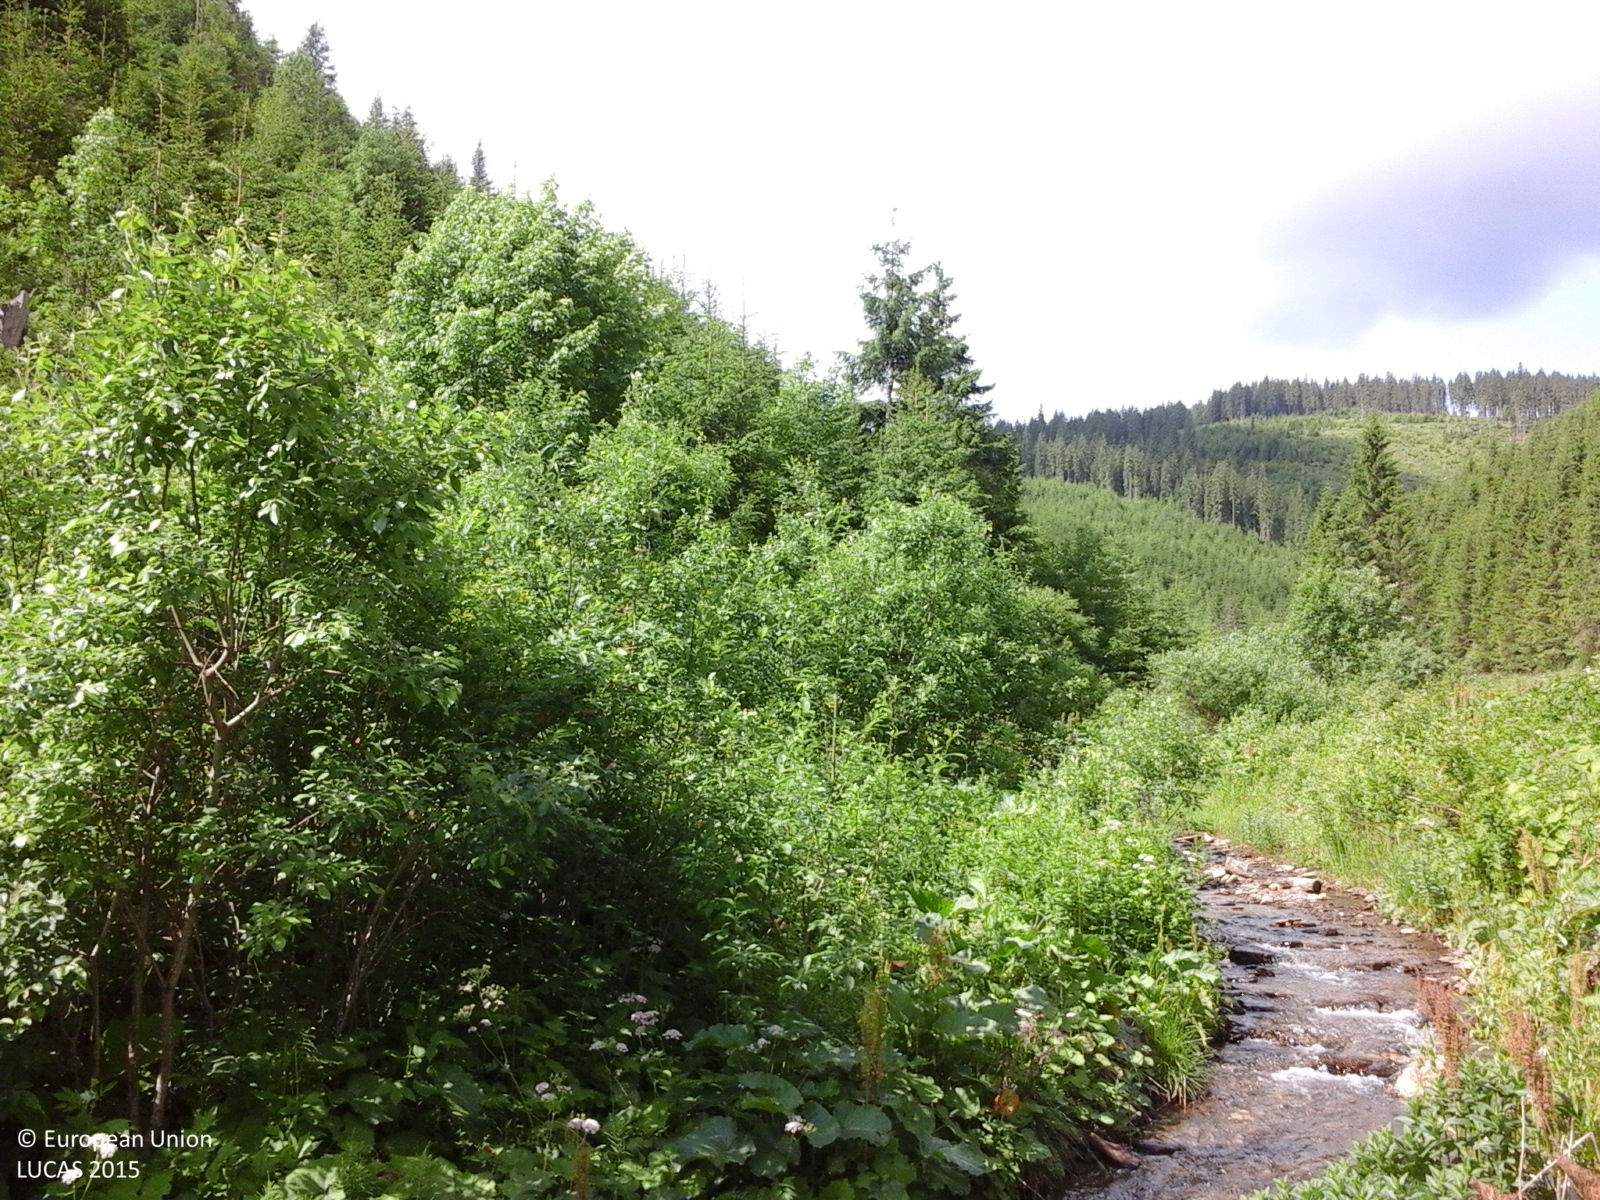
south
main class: Woodland
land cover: Spruce dominated mixed woodland
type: alpine coniferous forest
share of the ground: > 75 %
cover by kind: coniferous forest trees 75 %, broadleaved forest trees 25 %
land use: Forestry
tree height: > 5 m
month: June
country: RO
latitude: 47.2985
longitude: 25.5221
